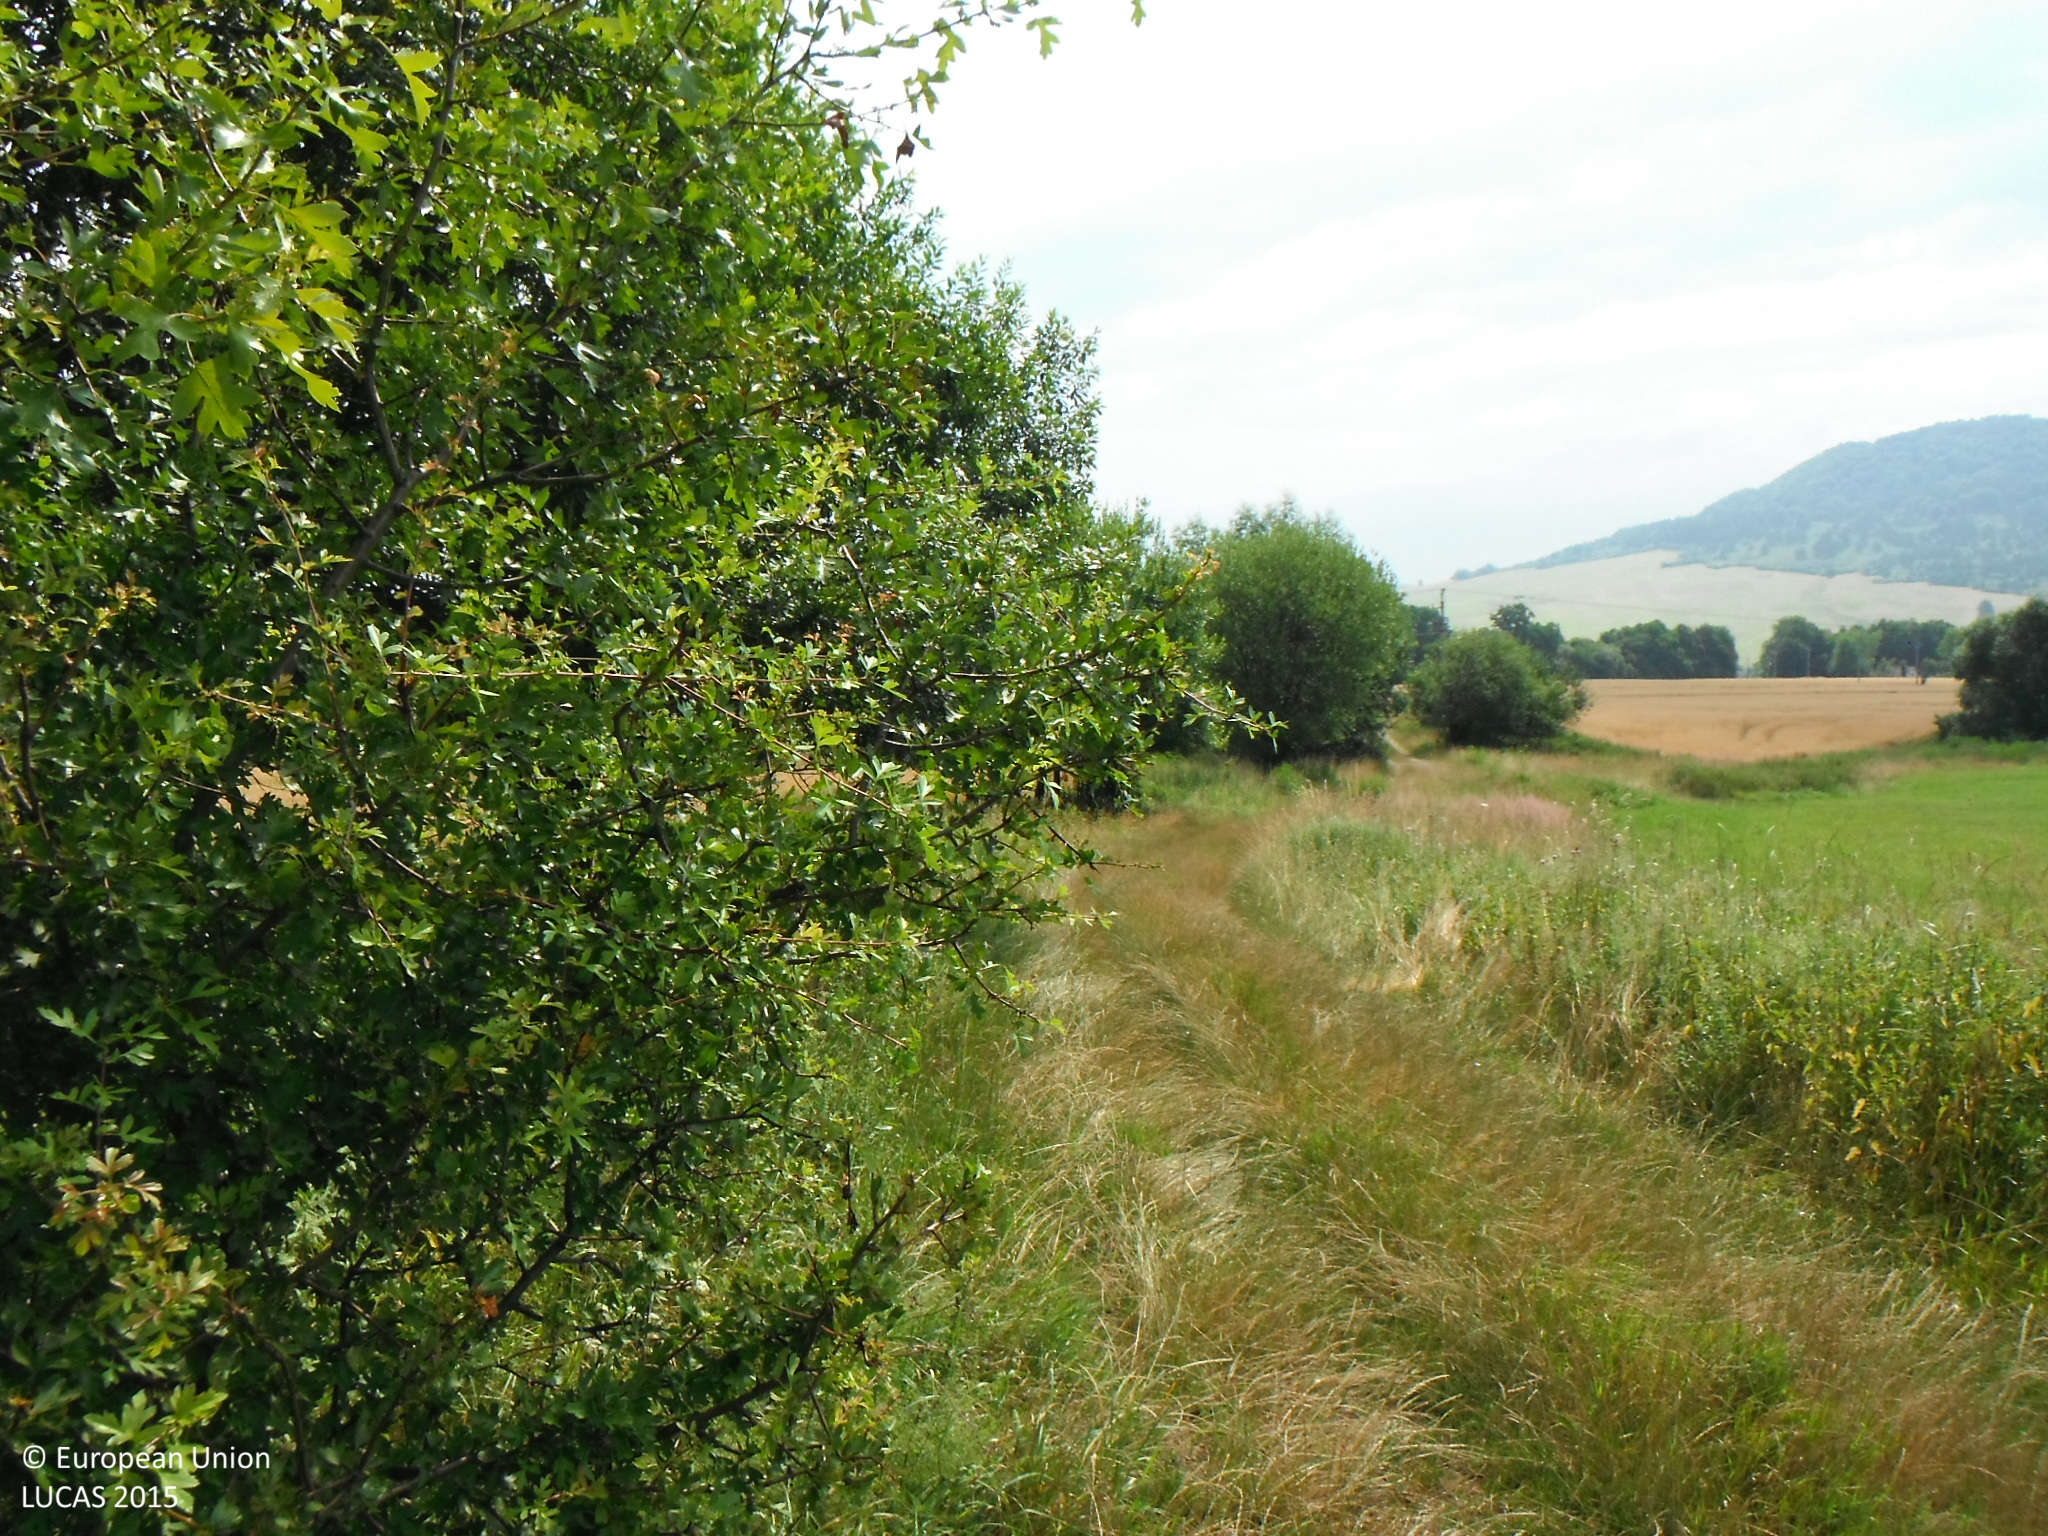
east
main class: Woodland
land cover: Broadleaved woodland
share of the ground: > 75 %
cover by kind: broadleaved forest trees 90 %, herbaceous plants 10 %
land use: Semi-natural and natural areas not in use
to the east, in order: Tracks; Broadleaved woodland; Spontaneously vegetated surfaces; Single bushes/trees; Ditches and canals; Common wheat; Spontaneously vegetated surfaces; Common wheat; Electric lines; Common wheat
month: July
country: SK
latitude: 49.3665
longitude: 21.2969
